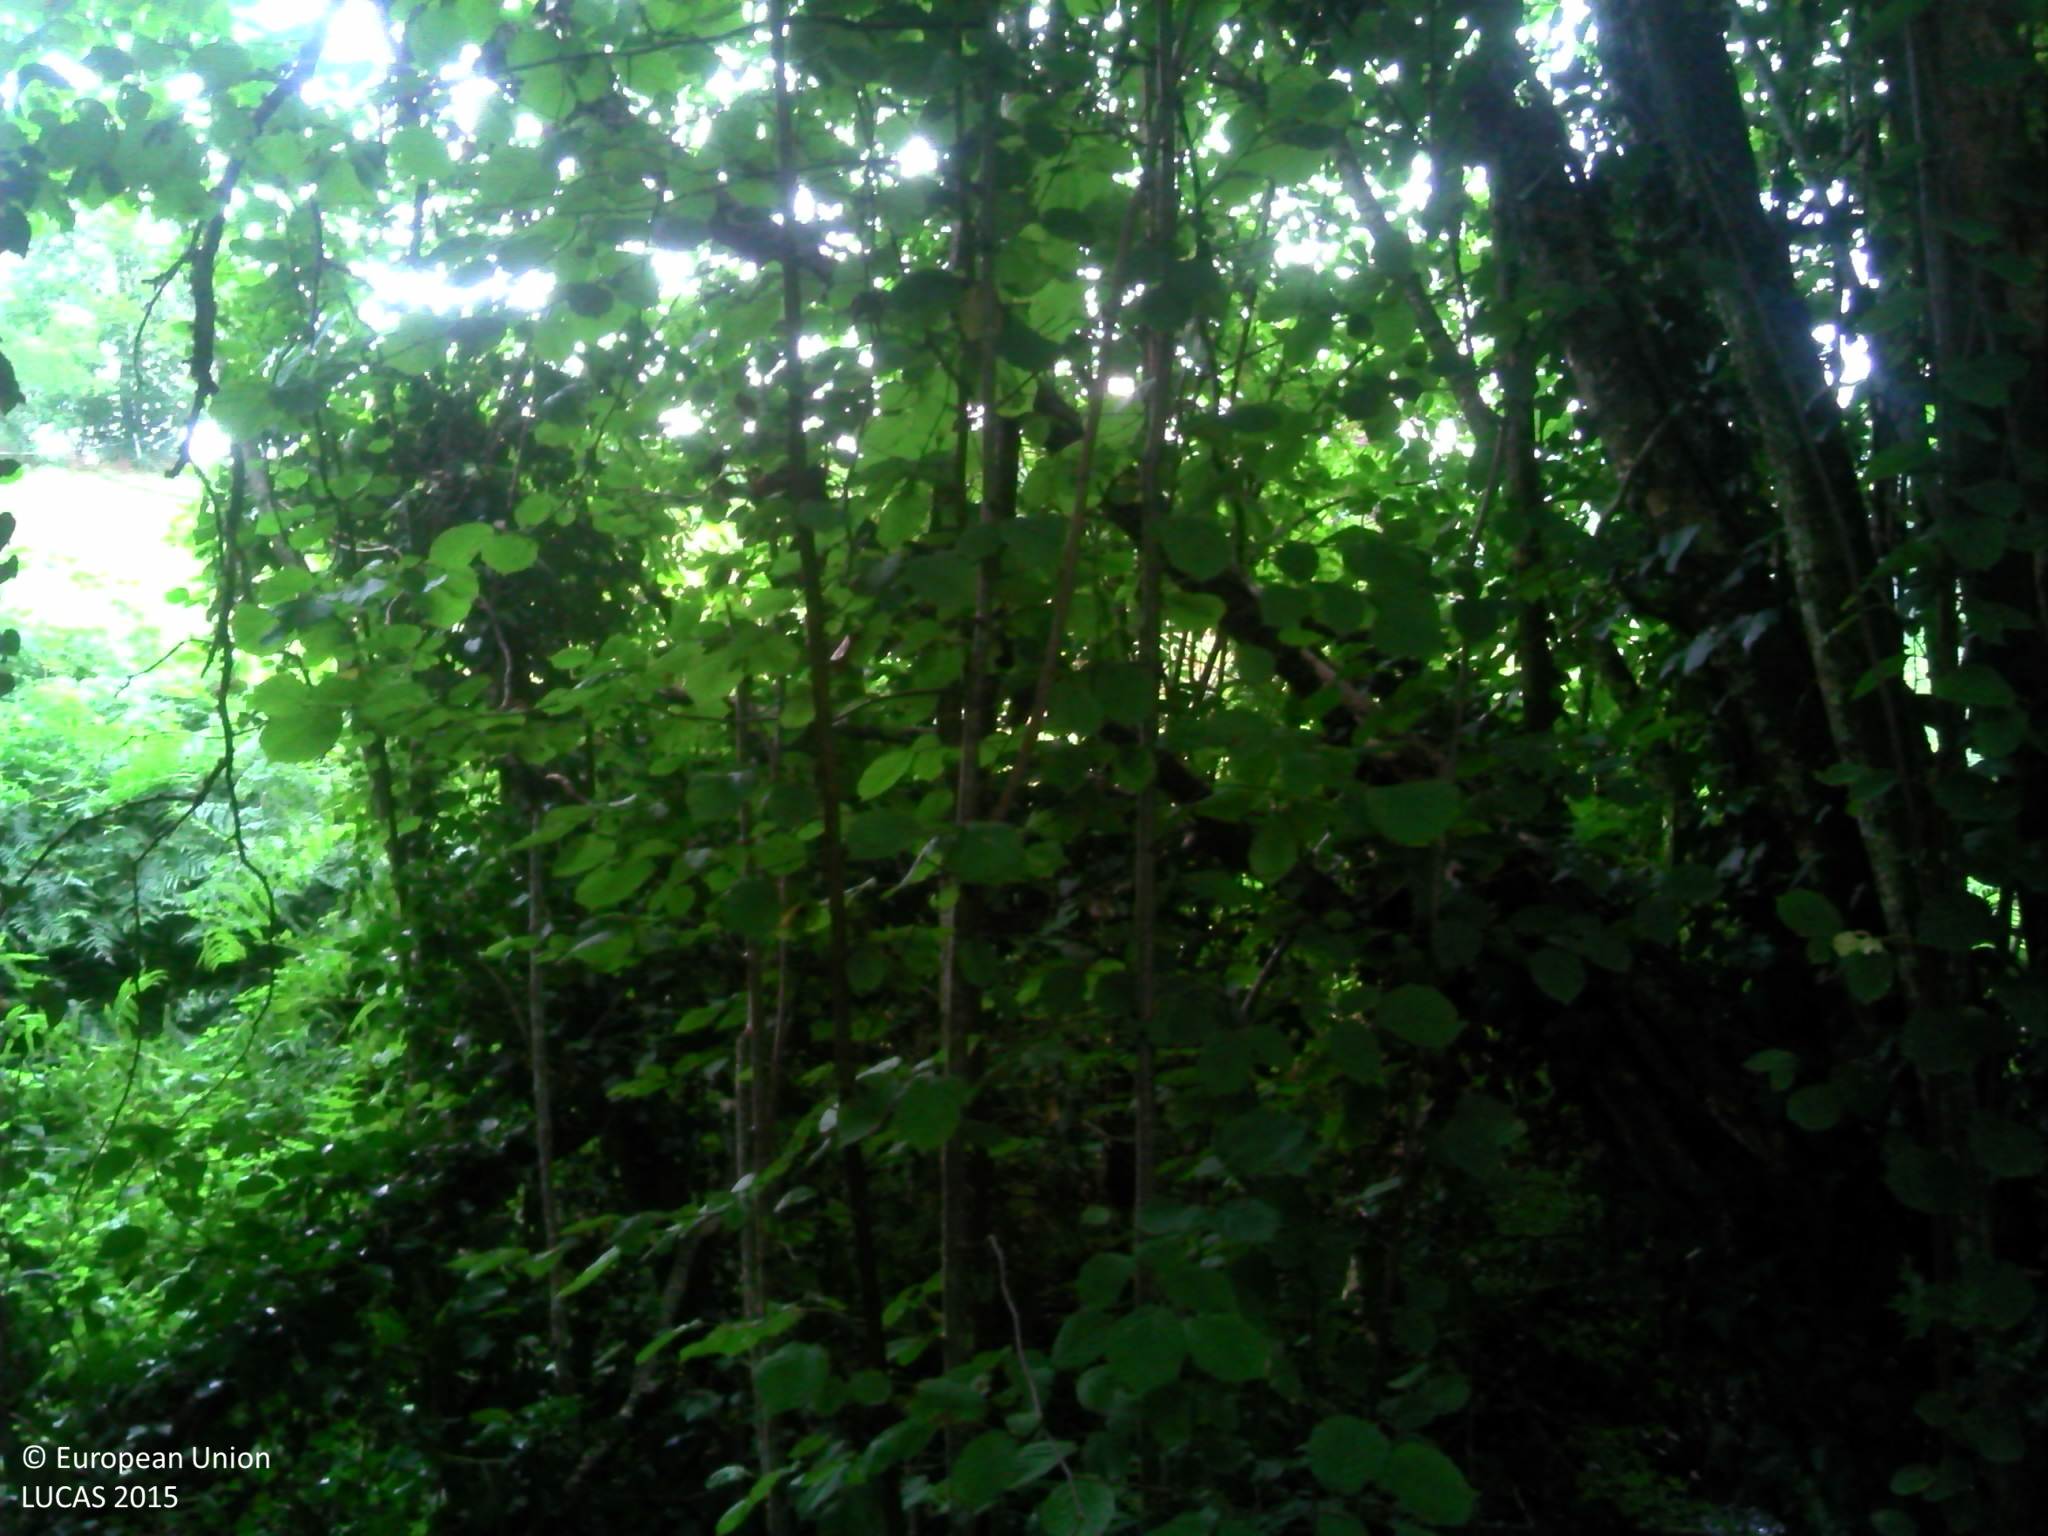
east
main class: Woodland
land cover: Broadleaved woodland
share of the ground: > 75 %
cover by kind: broadleaved forest trees 75 %, herbaceous plants 10 %, lichens and mosses 10 %, shrubs 5 %
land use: Forestry
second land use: Agriculture (excluding fallow land and kitchen gardens)
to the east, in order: Broadleaved woodland; Electric lines; Spontaneously vegetated surfaces; Grassland without tree/shrub cover; Fences; Abandoned hedges; Grassland without tree/shrub cover; Broadleaved woodland
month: August
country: FR
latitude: 46.3742
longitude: 2.2069
